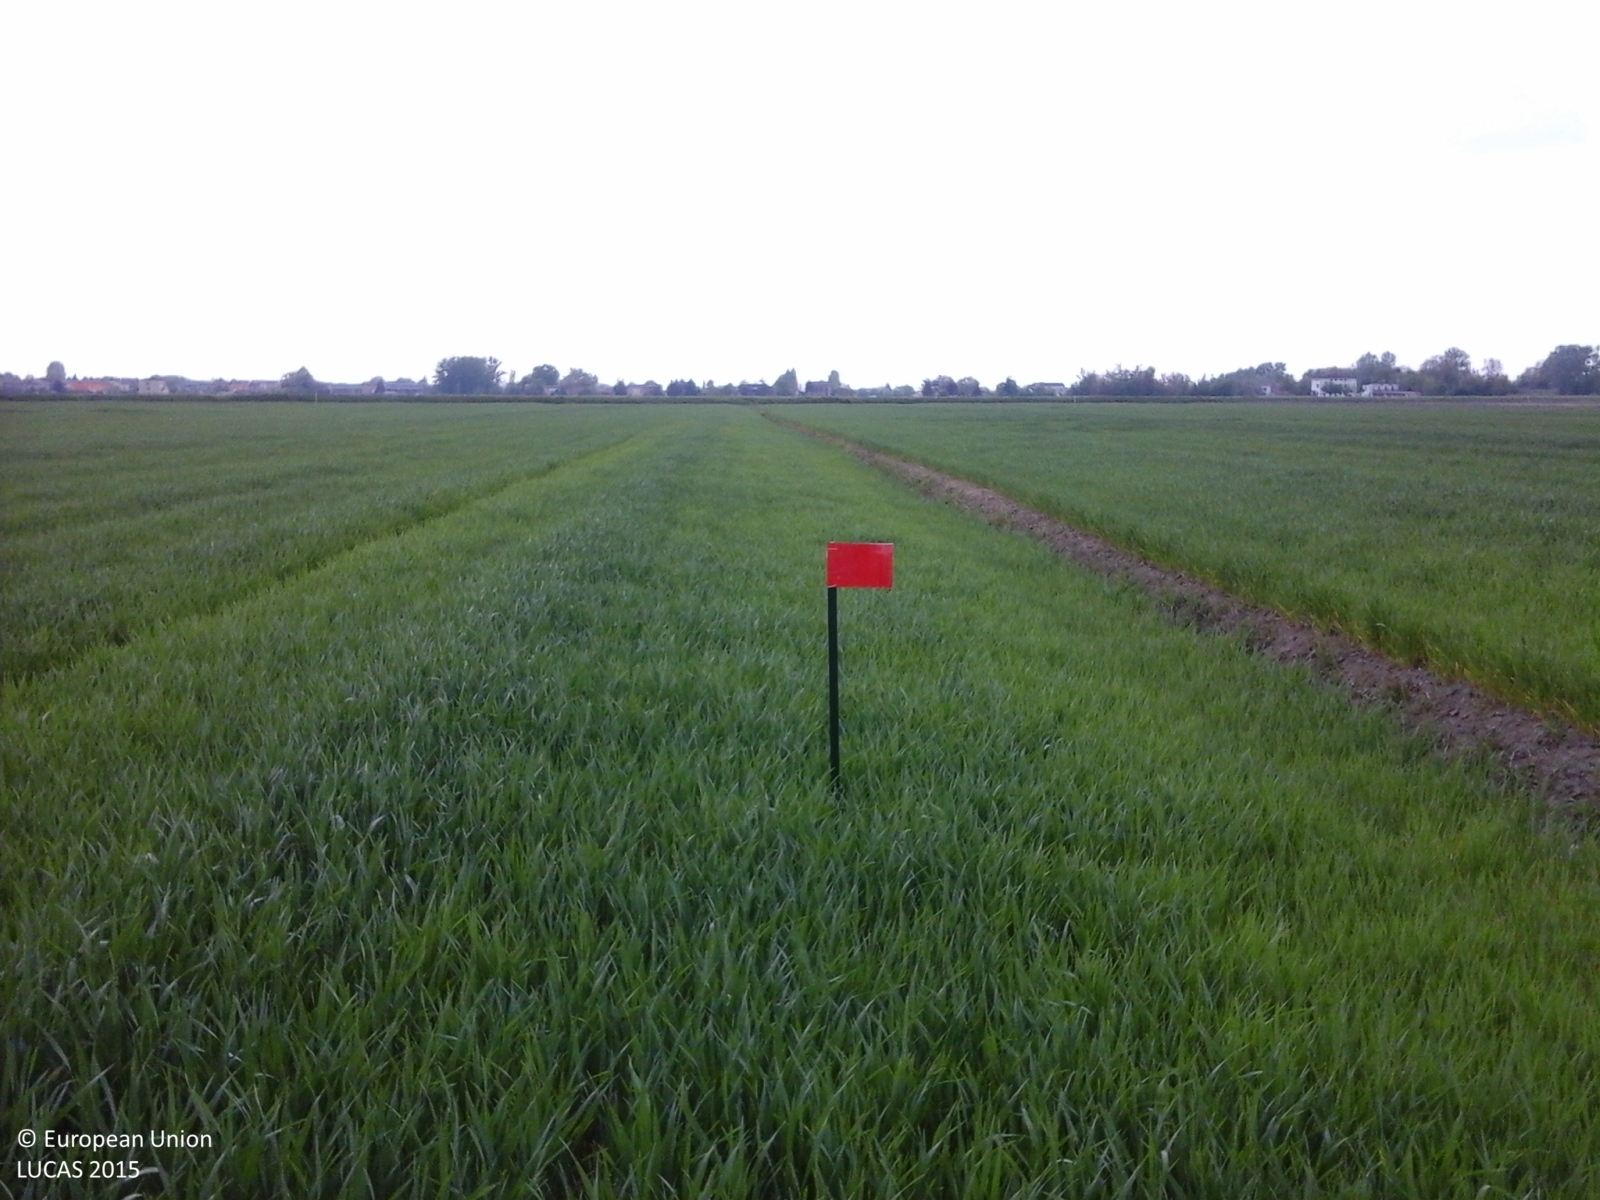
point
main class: Cropland
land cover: Common wheat
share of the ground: > 75 %
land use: Agriculture (excluding fallow land and kitchen gardens)
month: April
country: IT
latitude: 44.9057
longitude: 10.8974
